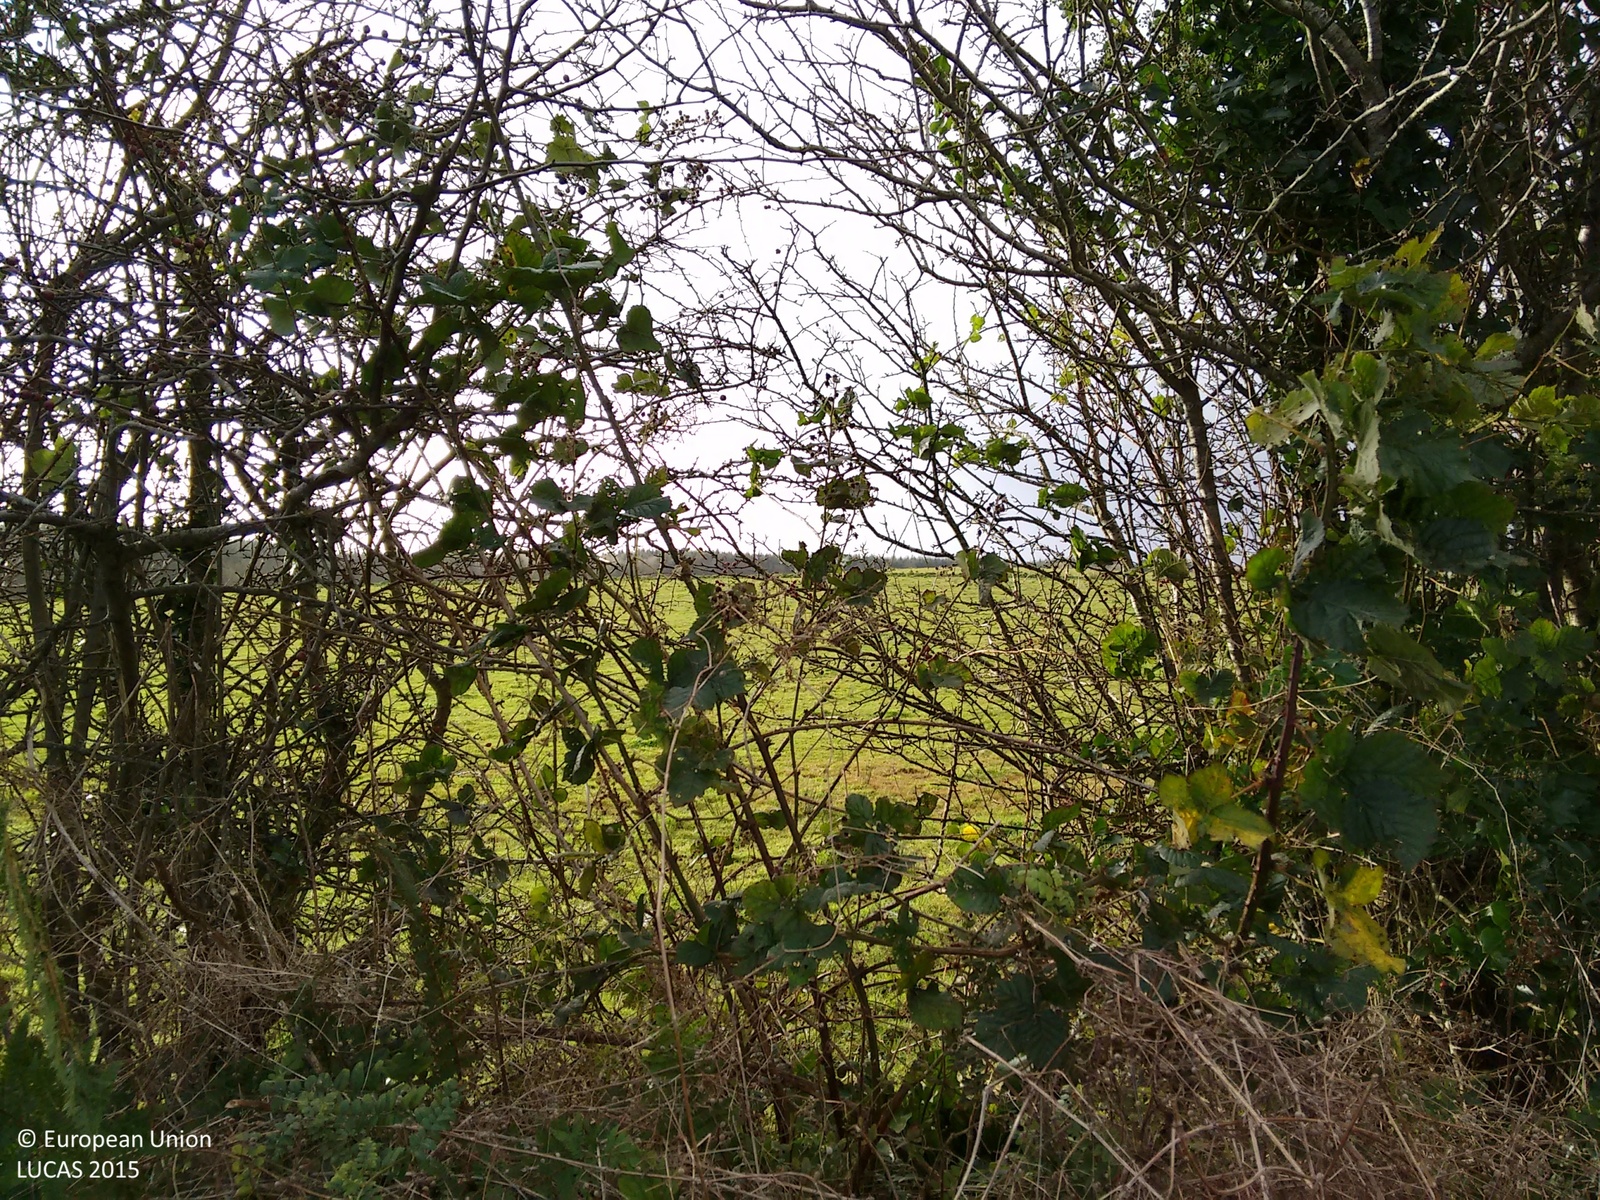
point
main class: Grassland
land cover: Grassland without tree/shrub cover
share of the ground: > 75 %
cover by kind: herbaceous plants 100 %
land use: Agriculture (excluding fallow land and kitchen gardens)
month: November
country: IE
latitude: 54.3535
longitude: -8.5493
